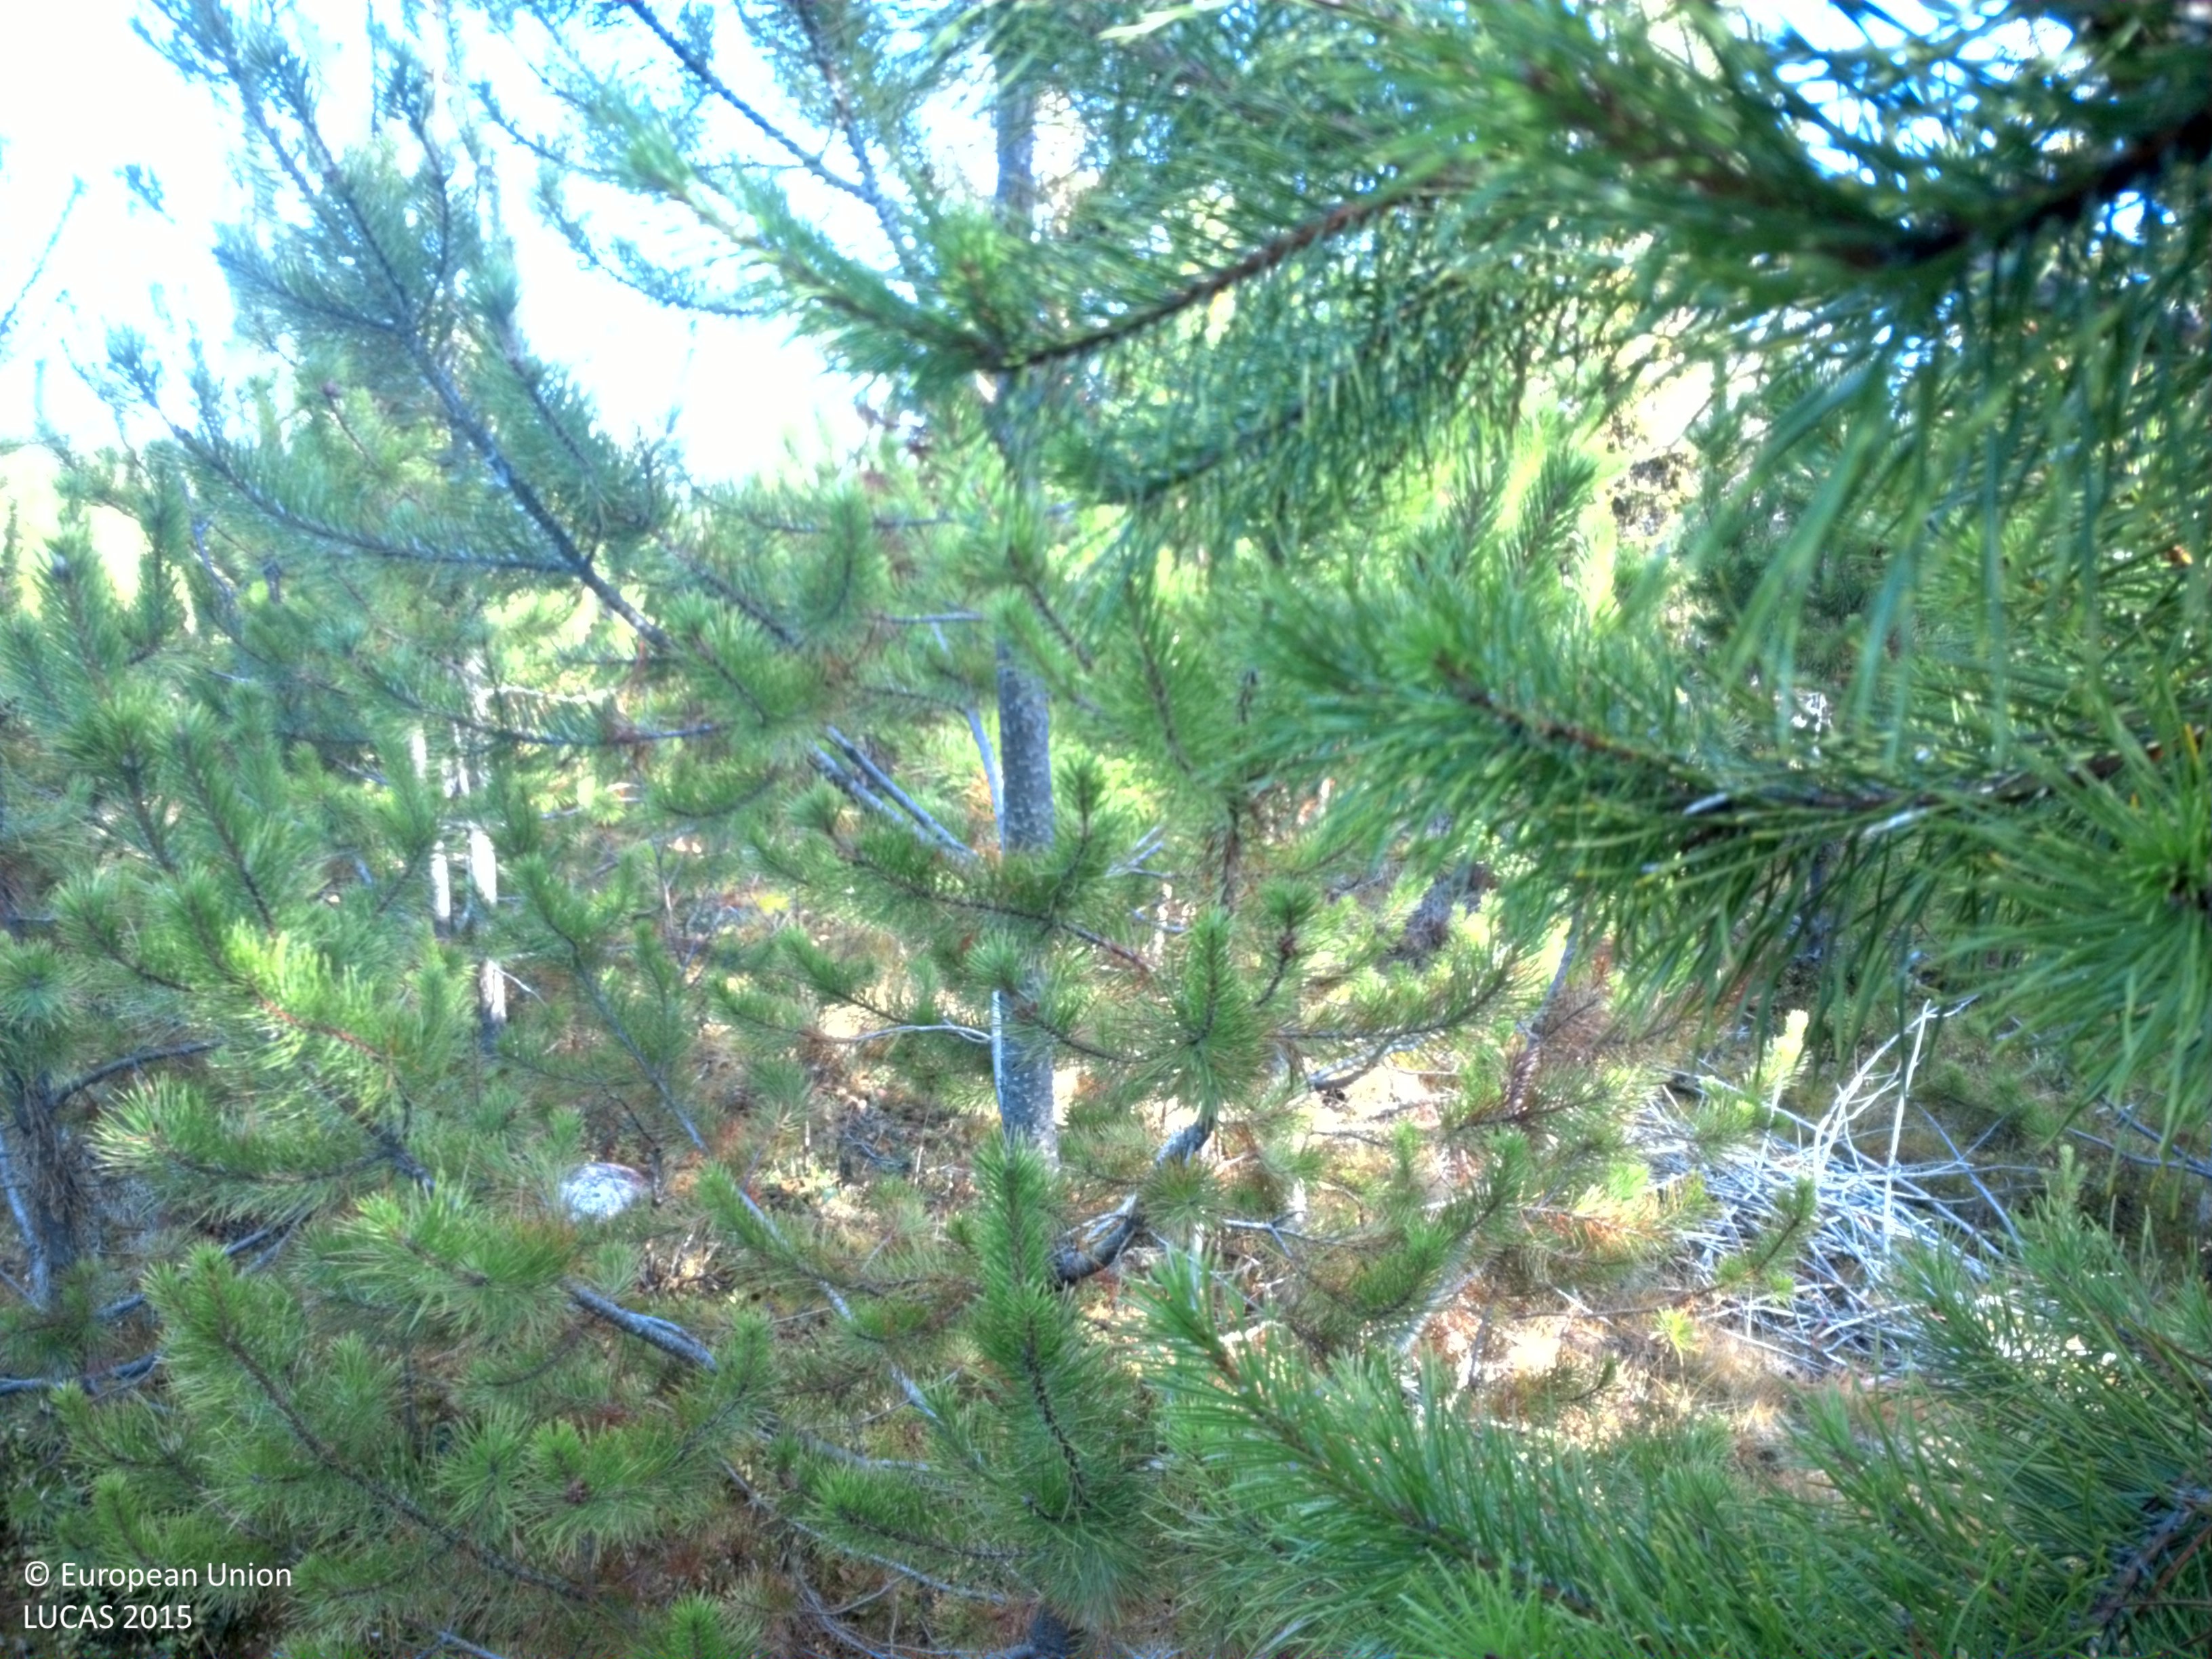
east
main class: Woodland
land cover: Pine dominated coniferous woodland
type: exotic forest
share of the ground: 25 - 50 %
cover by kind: coniferous forest trees 55 %, lichens and mosses 25 %, shrubs 10 %, herbaceous plants 10 %
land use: Forestry
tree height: < 5 m
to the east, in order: Pine dominated coniferous woodland; Other coniferous woodland; Pine dominated coniferous woodland; Shrubland with sparse tree cover; Pine dominated coniferous woodland; Grassland with sparse tree/shrub cover; Other mixed woodland
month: September
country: SE
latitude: 64.8884
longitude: 17.5882
